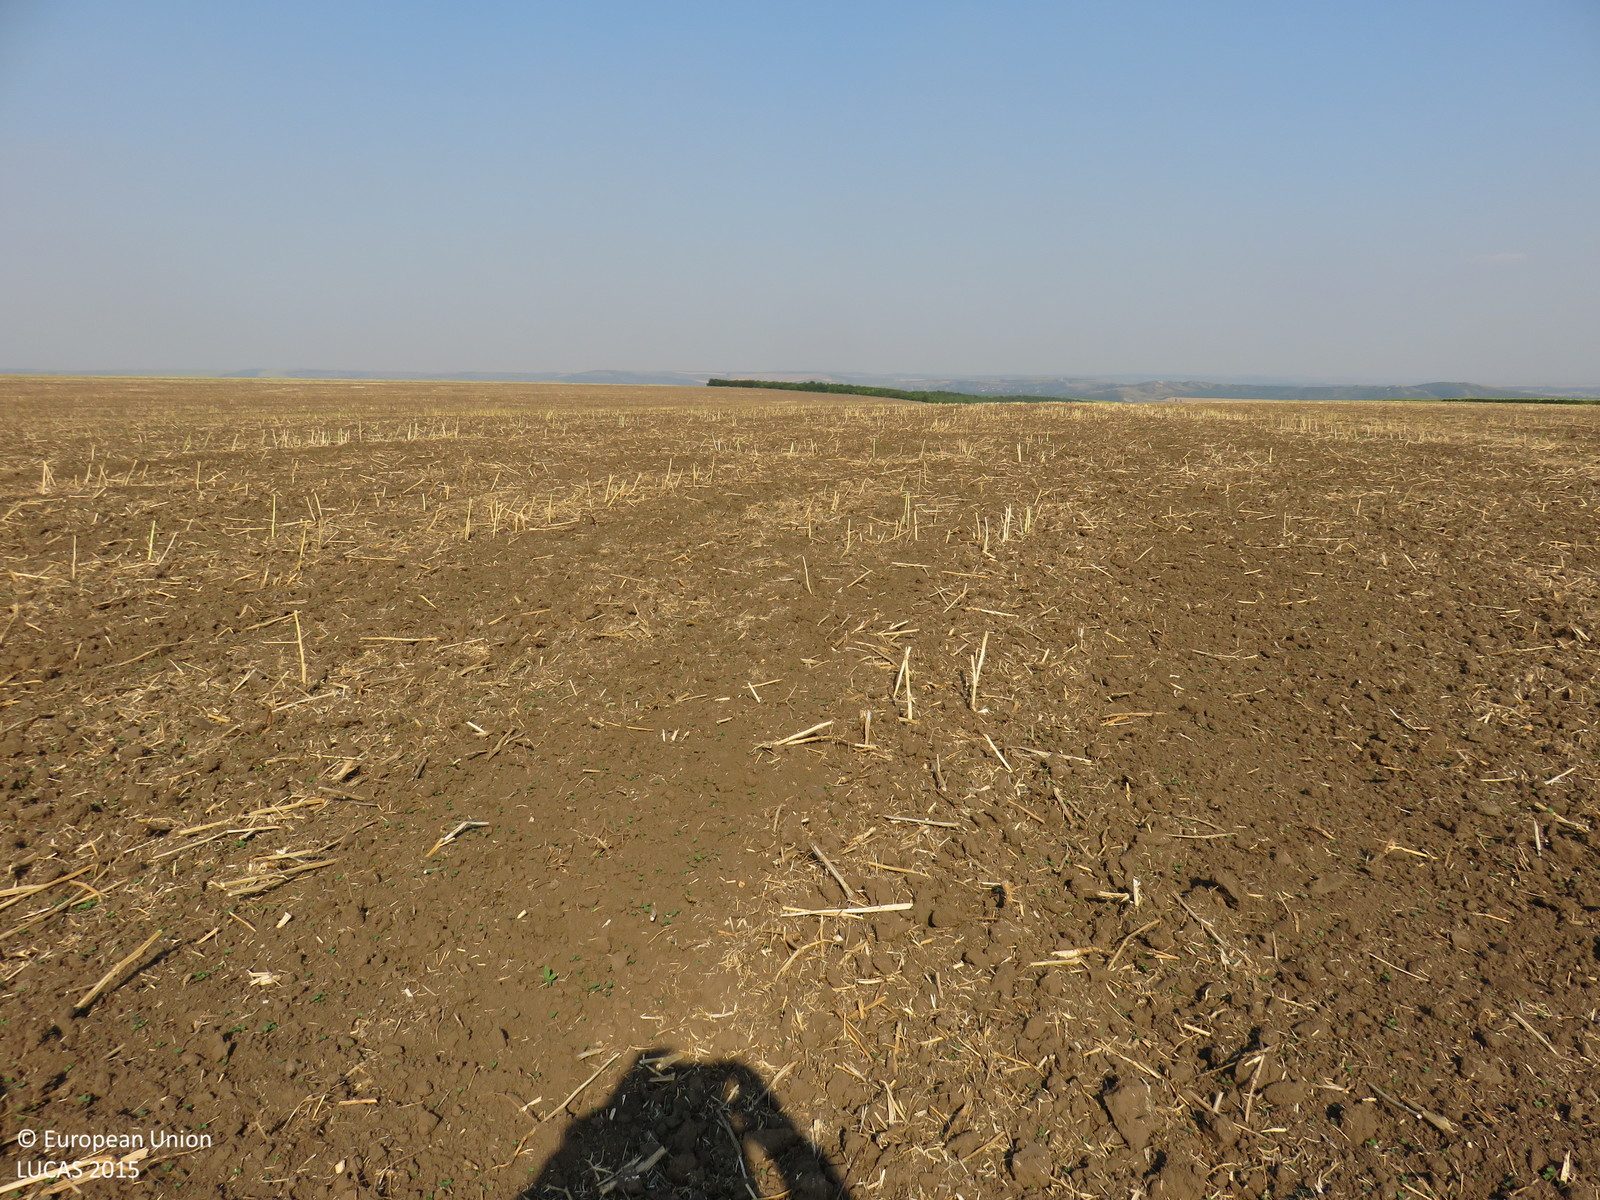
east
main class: Cropland
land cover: Rape and turnip rape
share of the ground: < 10 %
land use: Agriculture (excluding fallow land and kitchen gardens)
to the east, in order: Rape and turnip rape
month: July
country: BG
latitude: 43.5059
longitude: 24.8993
